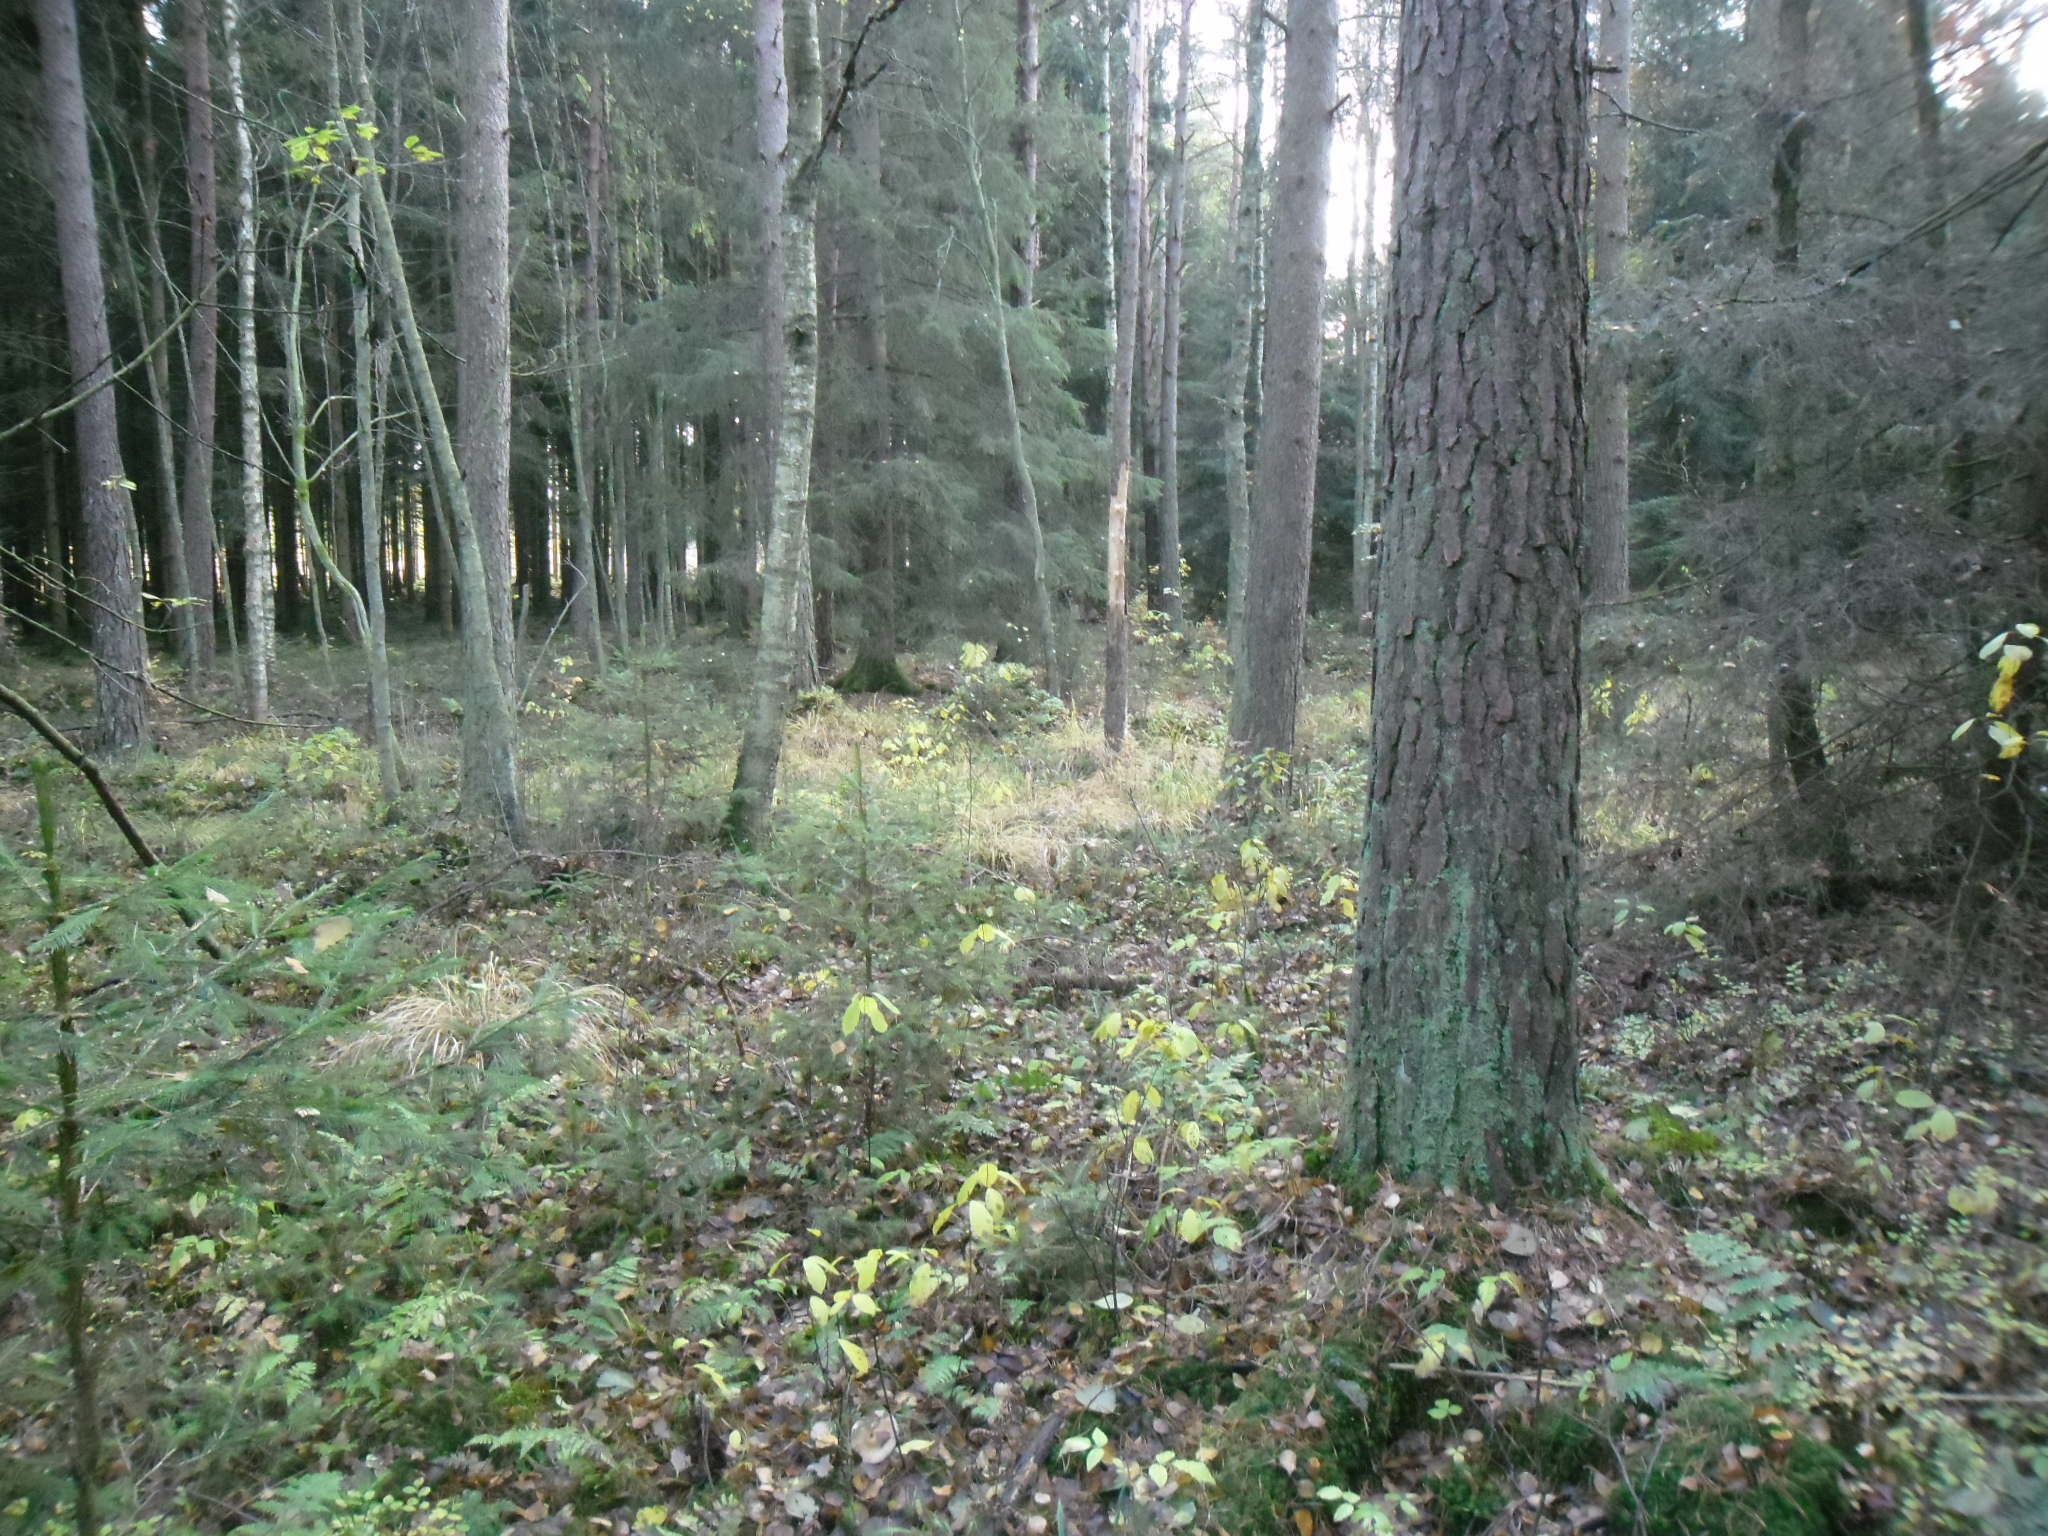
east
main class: Woodland
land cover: Pine dominated mixed woodland
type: boreal forest
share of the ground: > 75 %
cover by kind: coniferous forest trees 50 %, broadleaved forest trees 25 %, herbaceous plants 25 %
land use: Forestry
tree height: > 5 m
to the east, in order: Pine dominated mixed woodland; Spruce dominated coniferous woodland; Spontaneously vegetated surfaces; Broadleaved woodland; Grassland with sparse tree/shrub cover
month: October
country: SE
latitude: 56.3103
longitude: 13.1817
